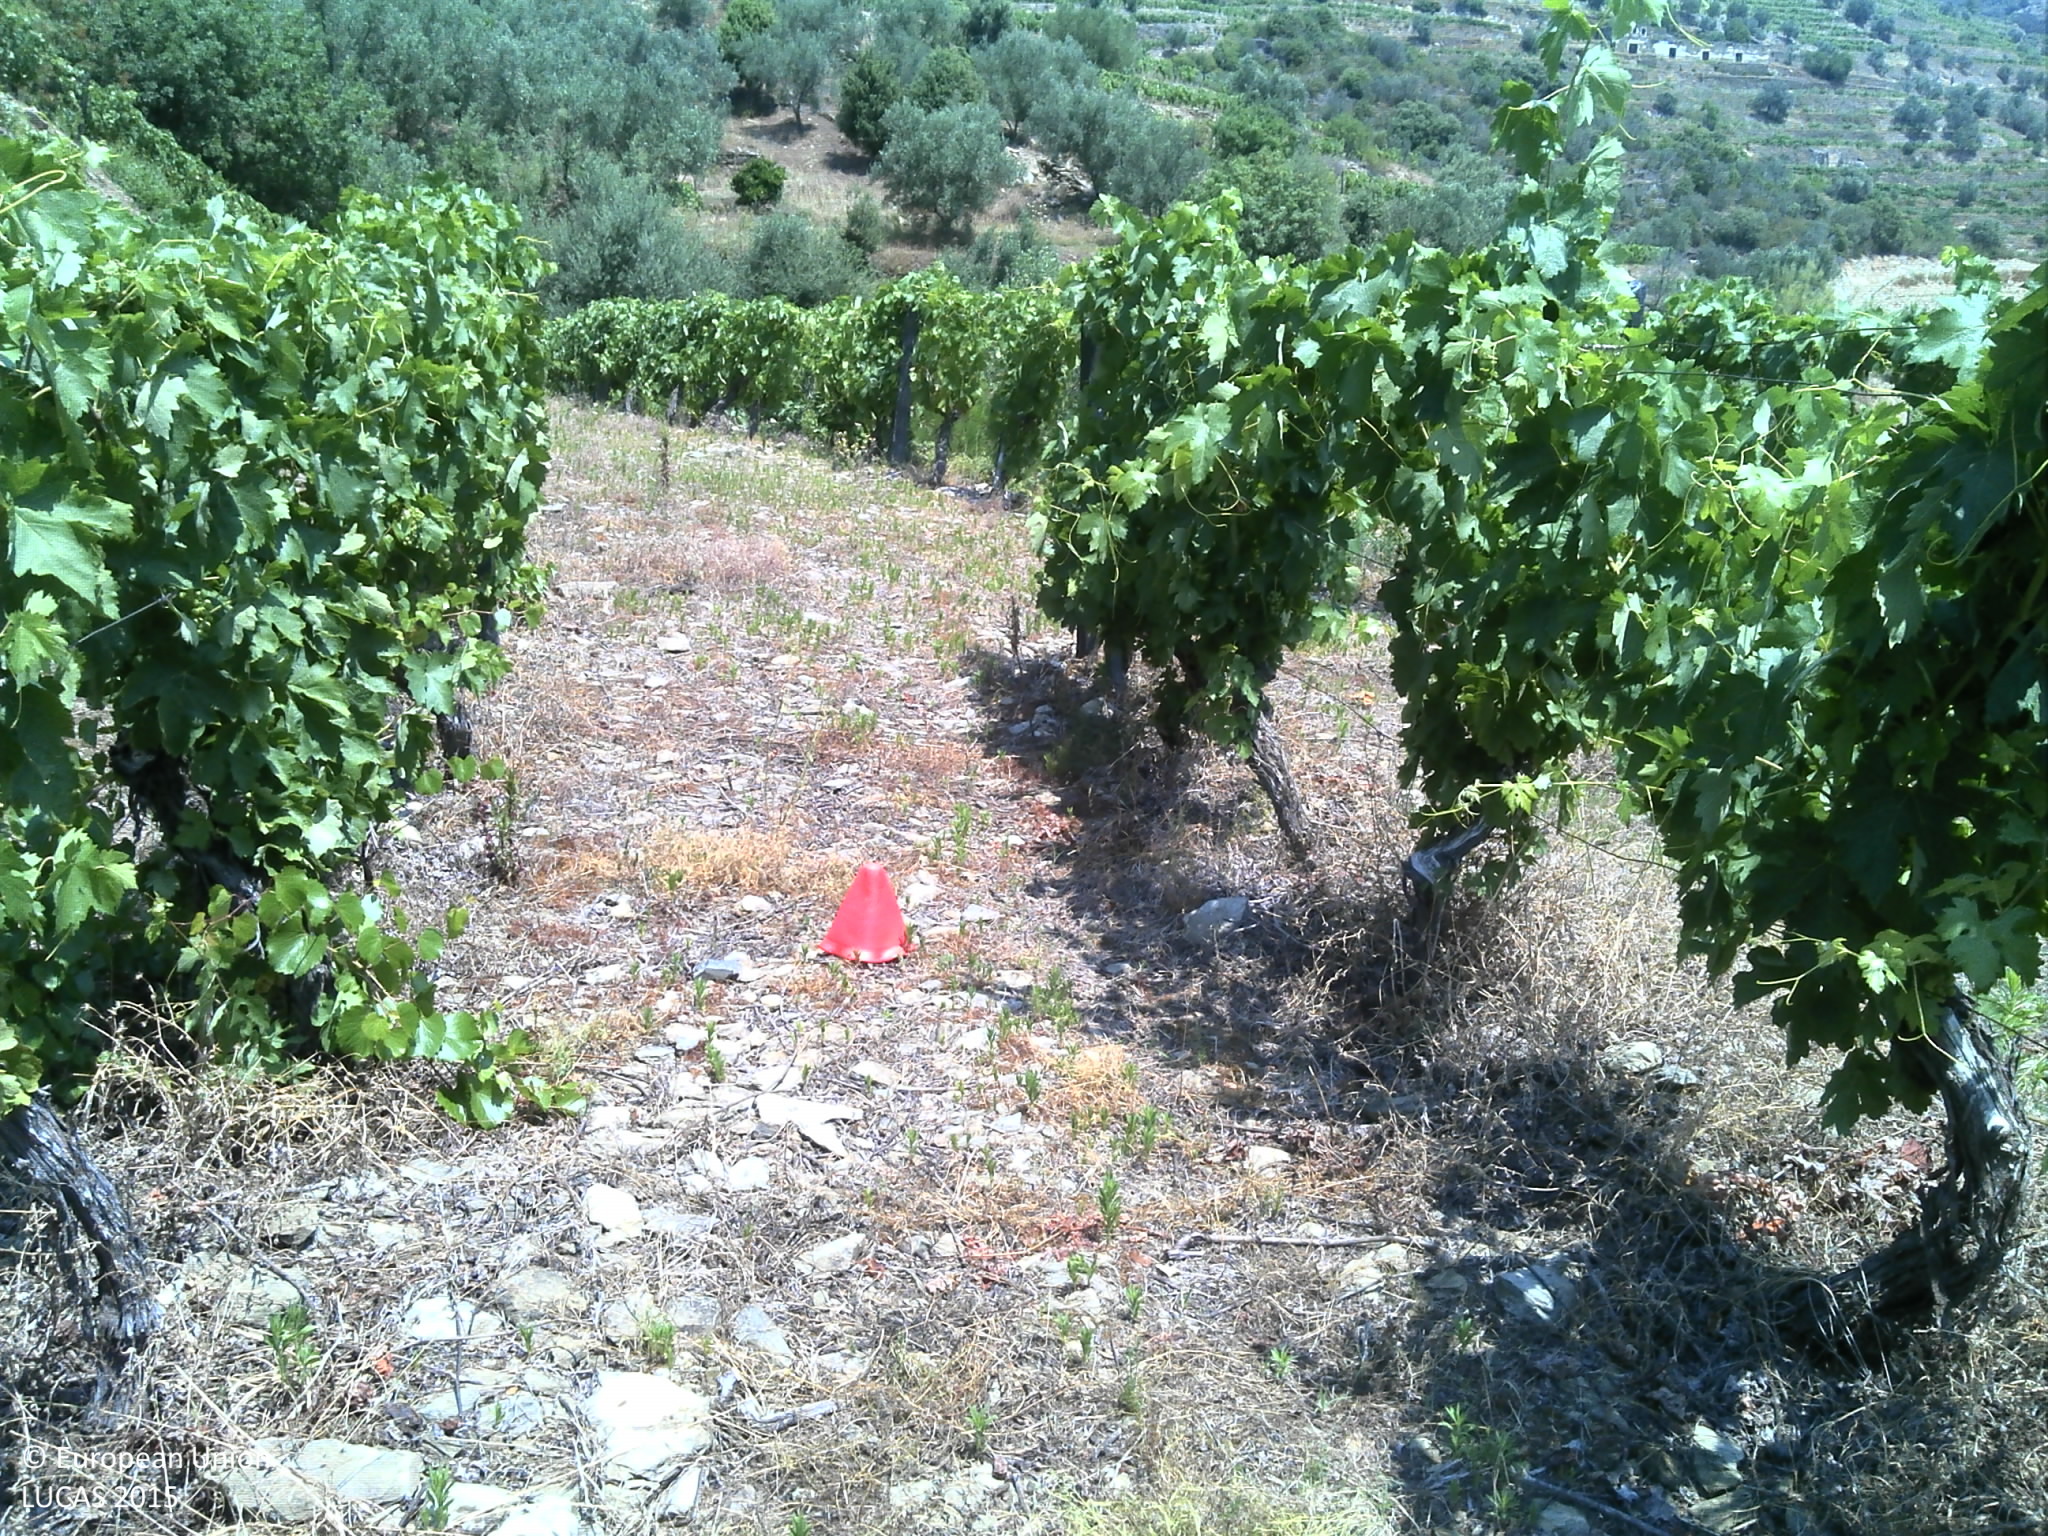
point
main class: Cropland
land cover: Vineyards
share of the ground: 10 - 25 %
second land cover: Spontaneously vegetated surfaces
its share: 10 - 25 %
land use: Agriculture (excluding fallow land and kitchen gardens)
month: June
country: PT
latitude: 41.2171
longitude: -7.4525
